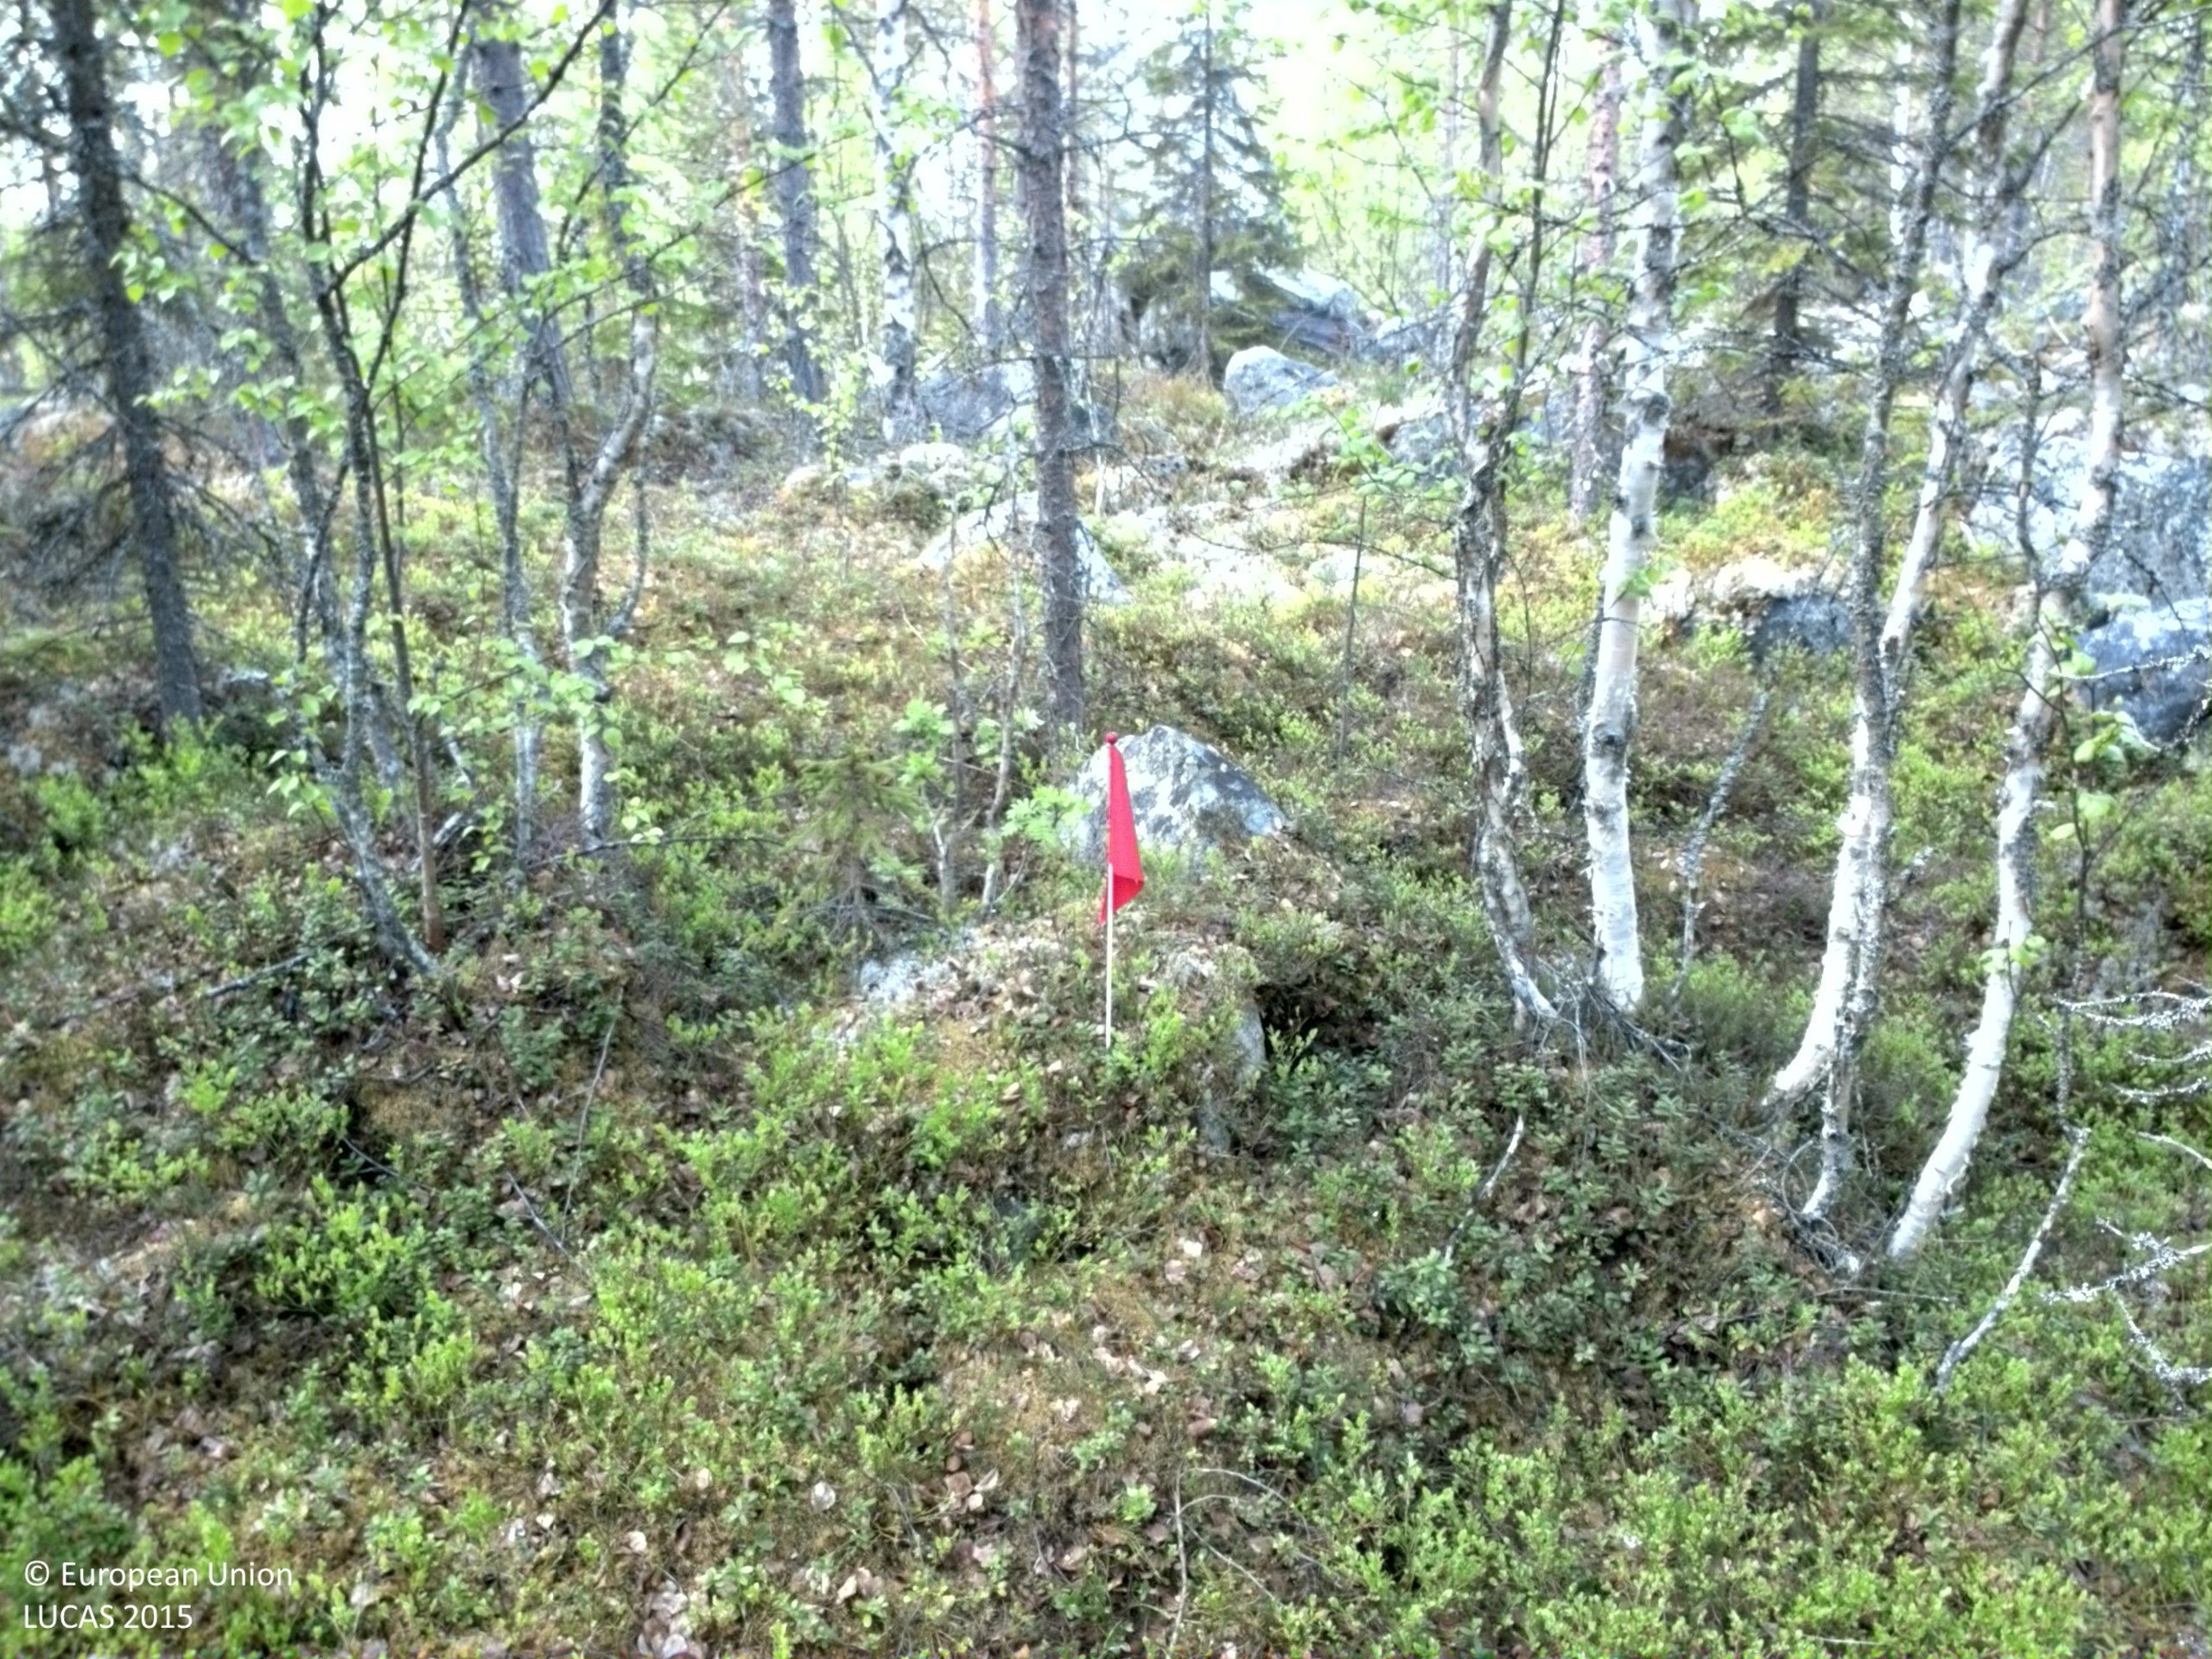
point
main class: Woodland
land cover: Pine dominated mixed woodland
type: boreal forest
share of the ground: 50 - 75 %
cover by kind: coniferous forest trees 50 %, shrubs 30 %, broadleaved forest trees 20 %
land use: Forestry
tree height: > 5 m
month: June
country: SE
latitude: 63.0204
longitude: 17.1881
